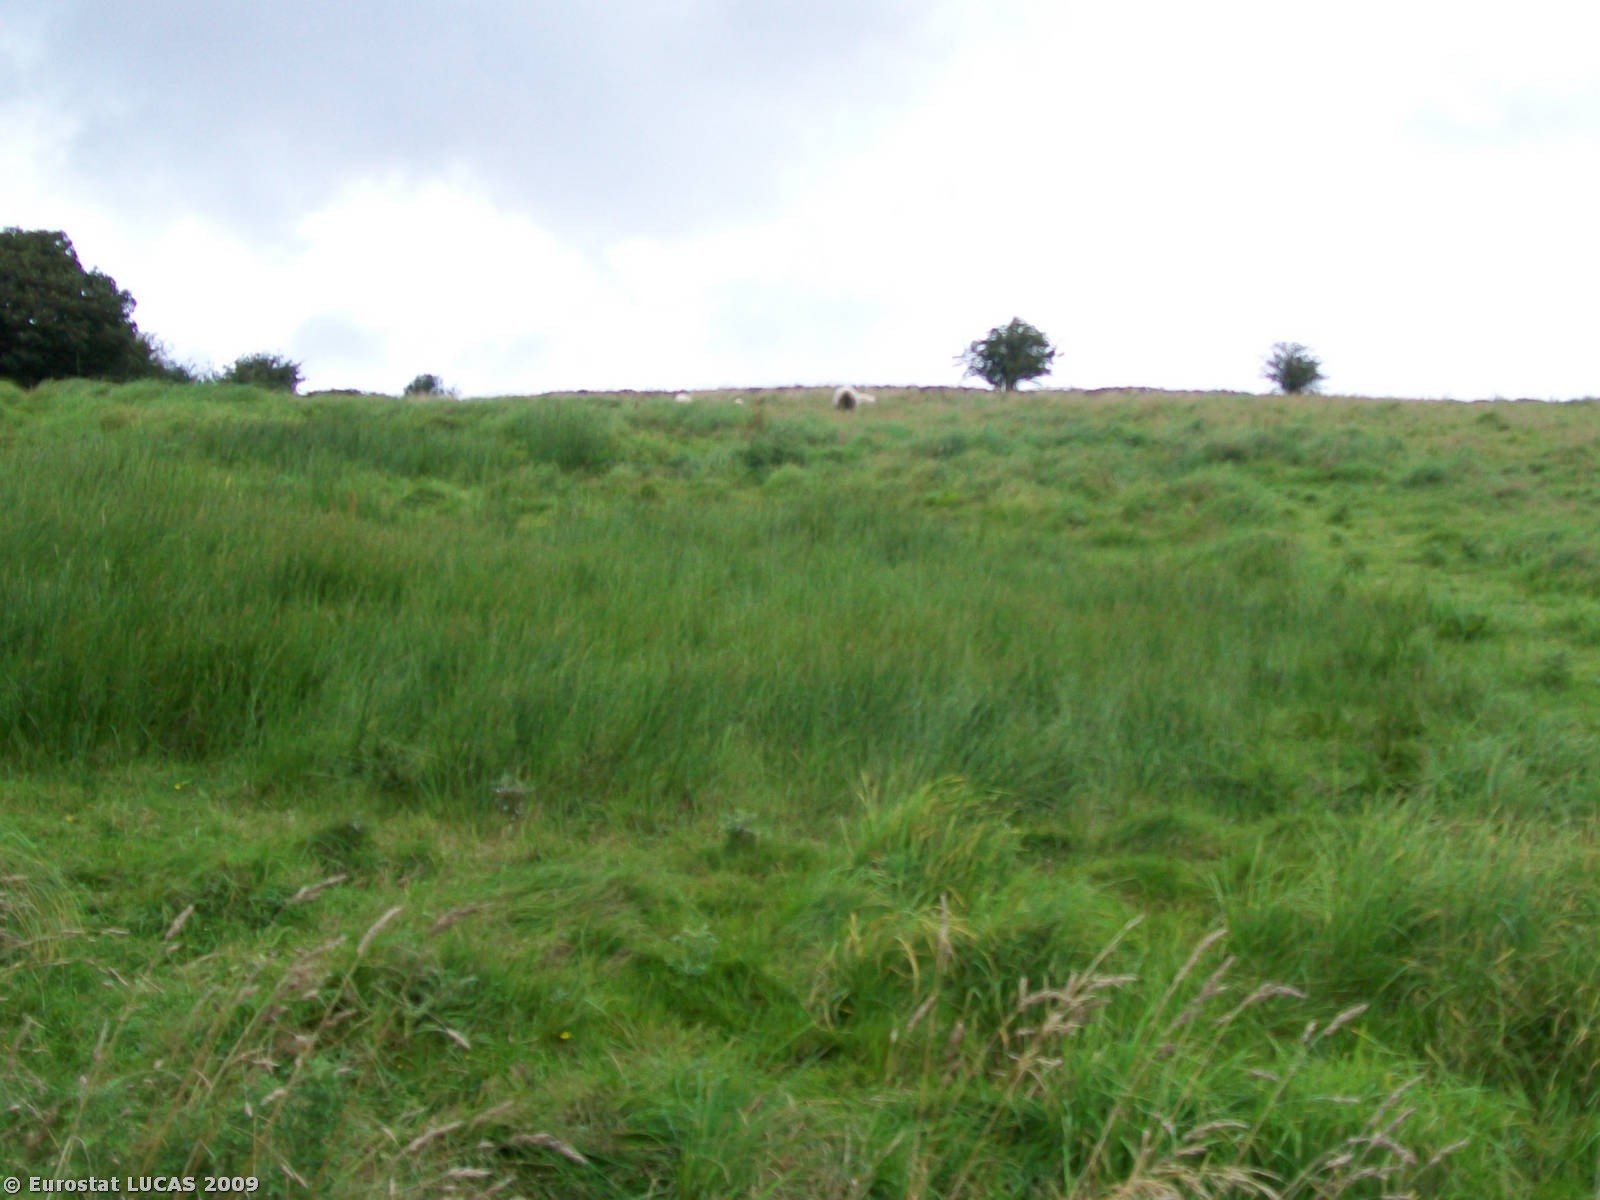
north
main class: Grassland
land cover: Grassland without tree/shrub cover
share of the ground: > 75 %
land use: Agriculture (excluding fallow land and kitchen gardens)
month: August
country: IE
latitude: 52.9645
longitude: -8.6769
